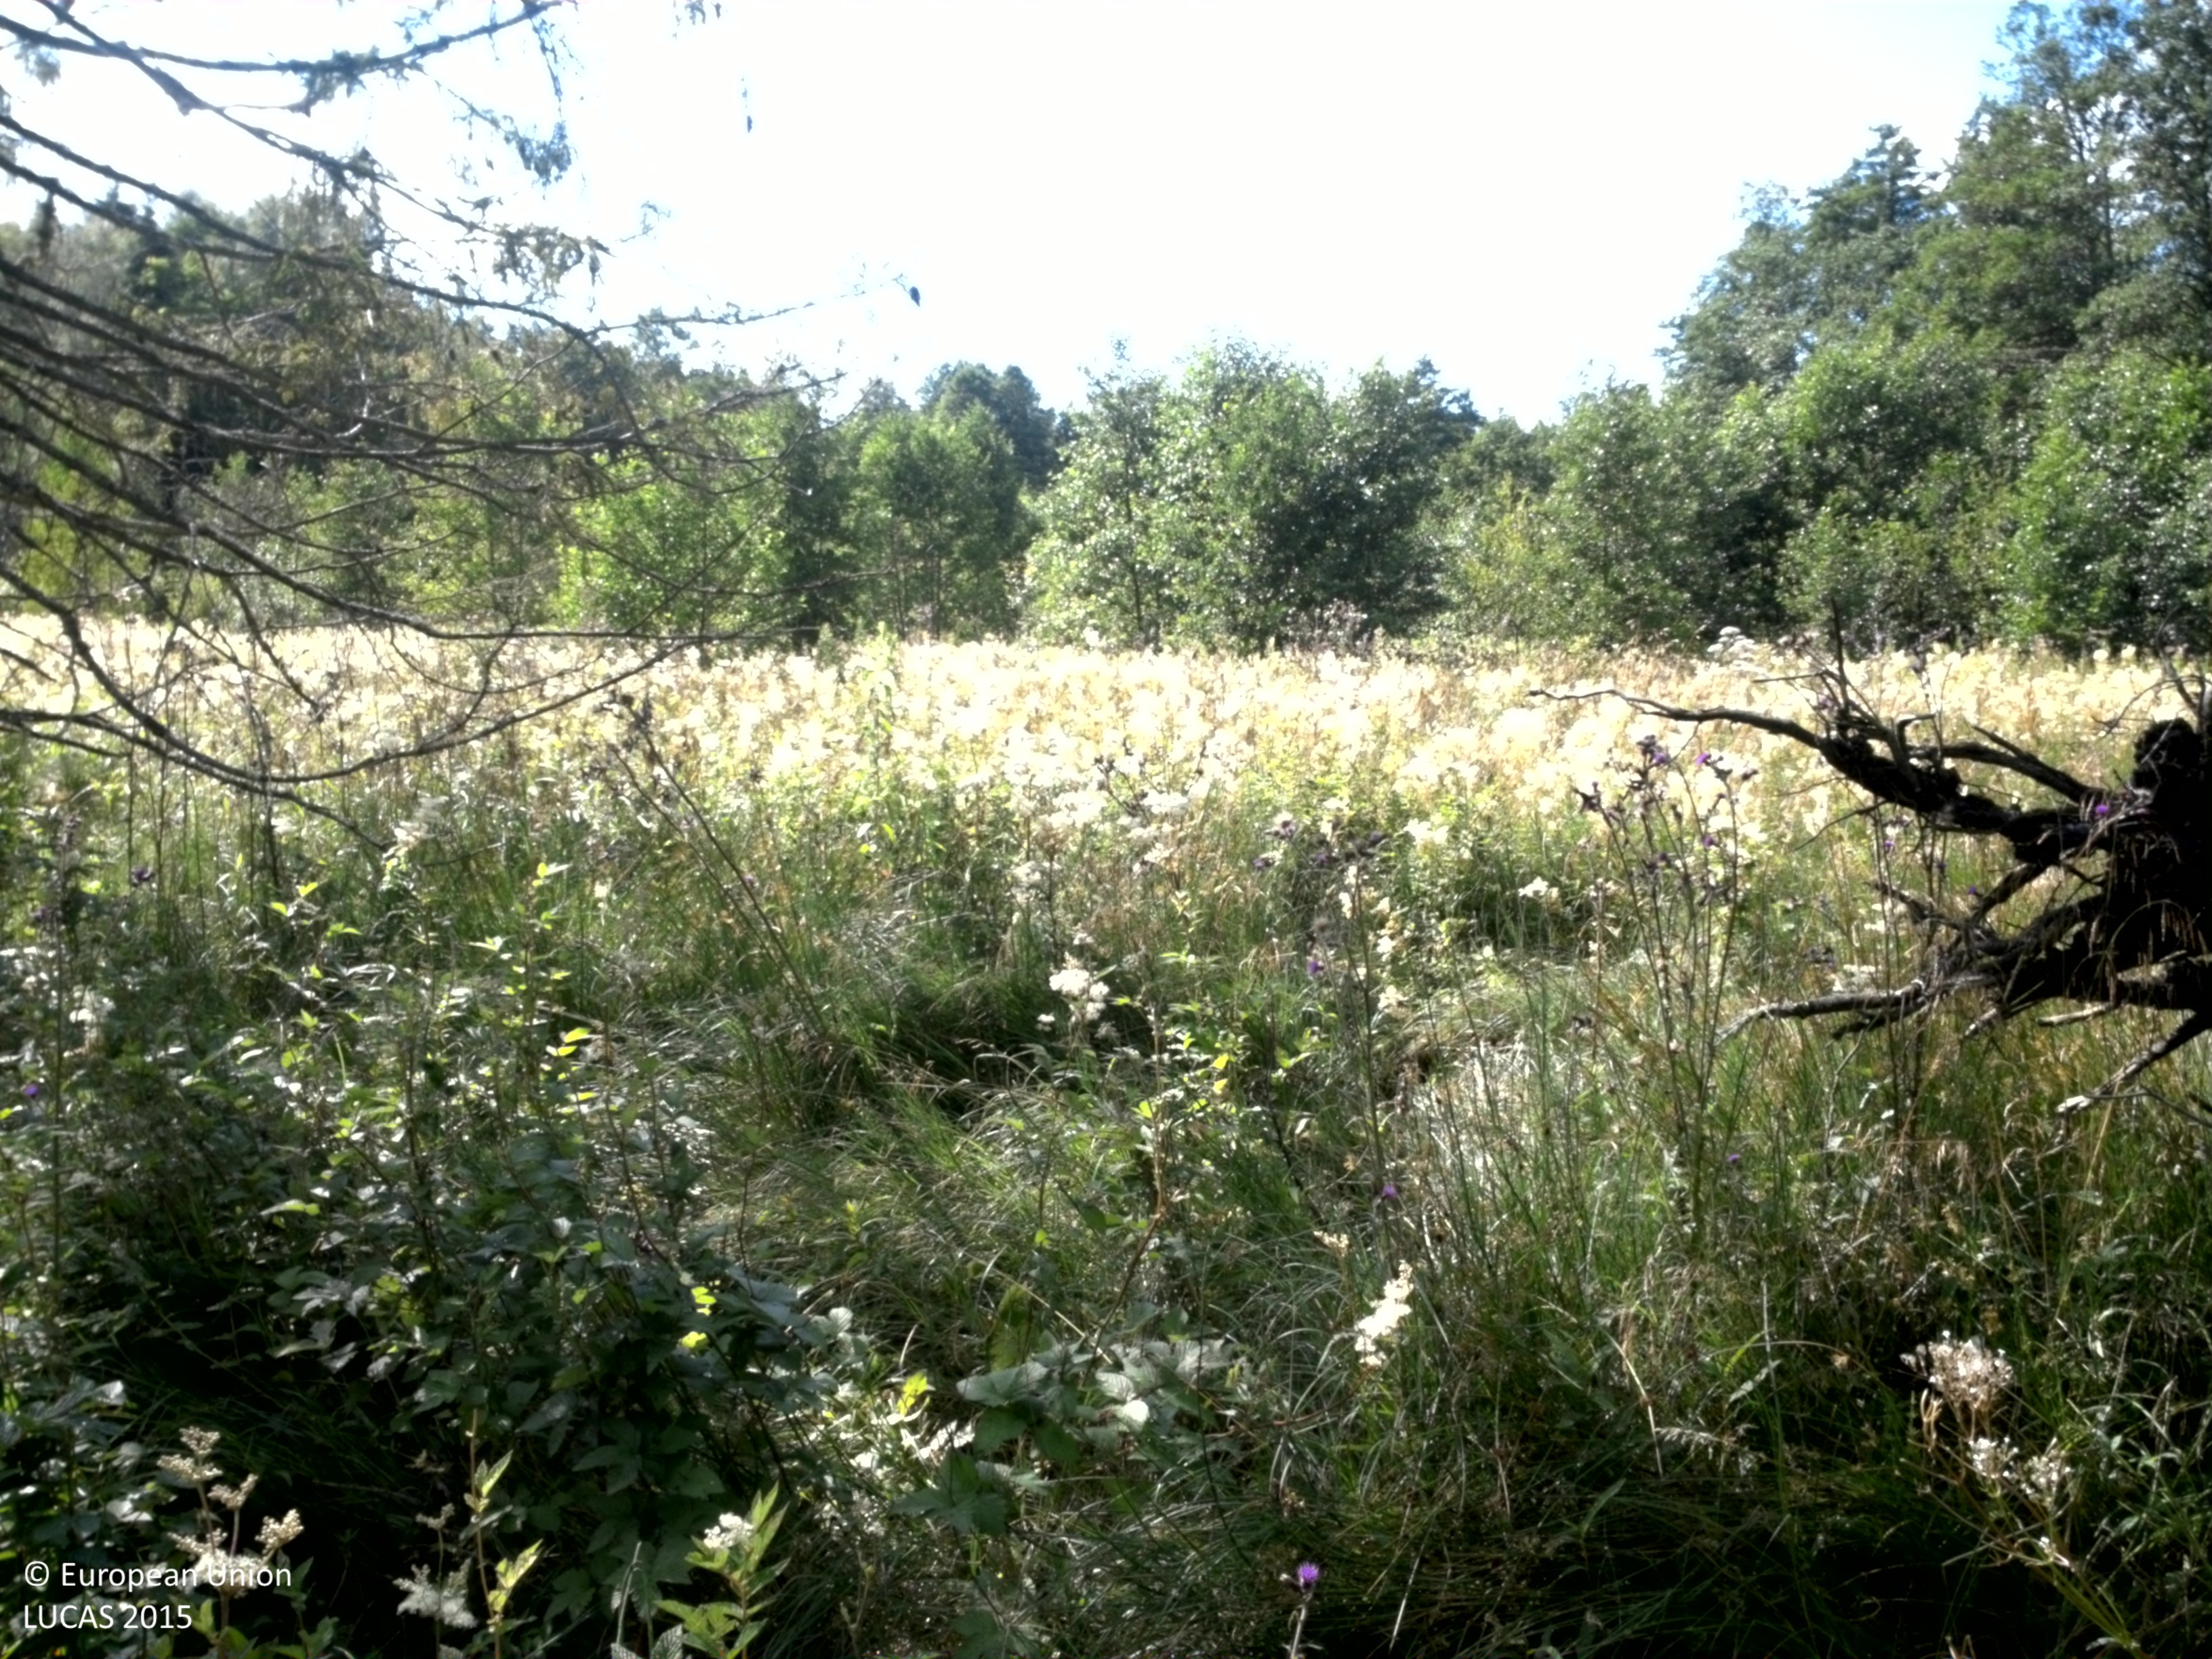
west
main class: Woodland
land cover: Spruce dominated mixed woodland
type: boreal forest
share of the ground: 25 - 50 %
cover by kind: herbaceous plants 70 %, coniferous forest trees 15 %, broadleaved forest trees 15 %
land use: Agriculture (excluding fallow land and kitchen gardens)
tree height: > 5 m
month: August
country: SE
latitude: 58.1085
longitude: 13.9146
